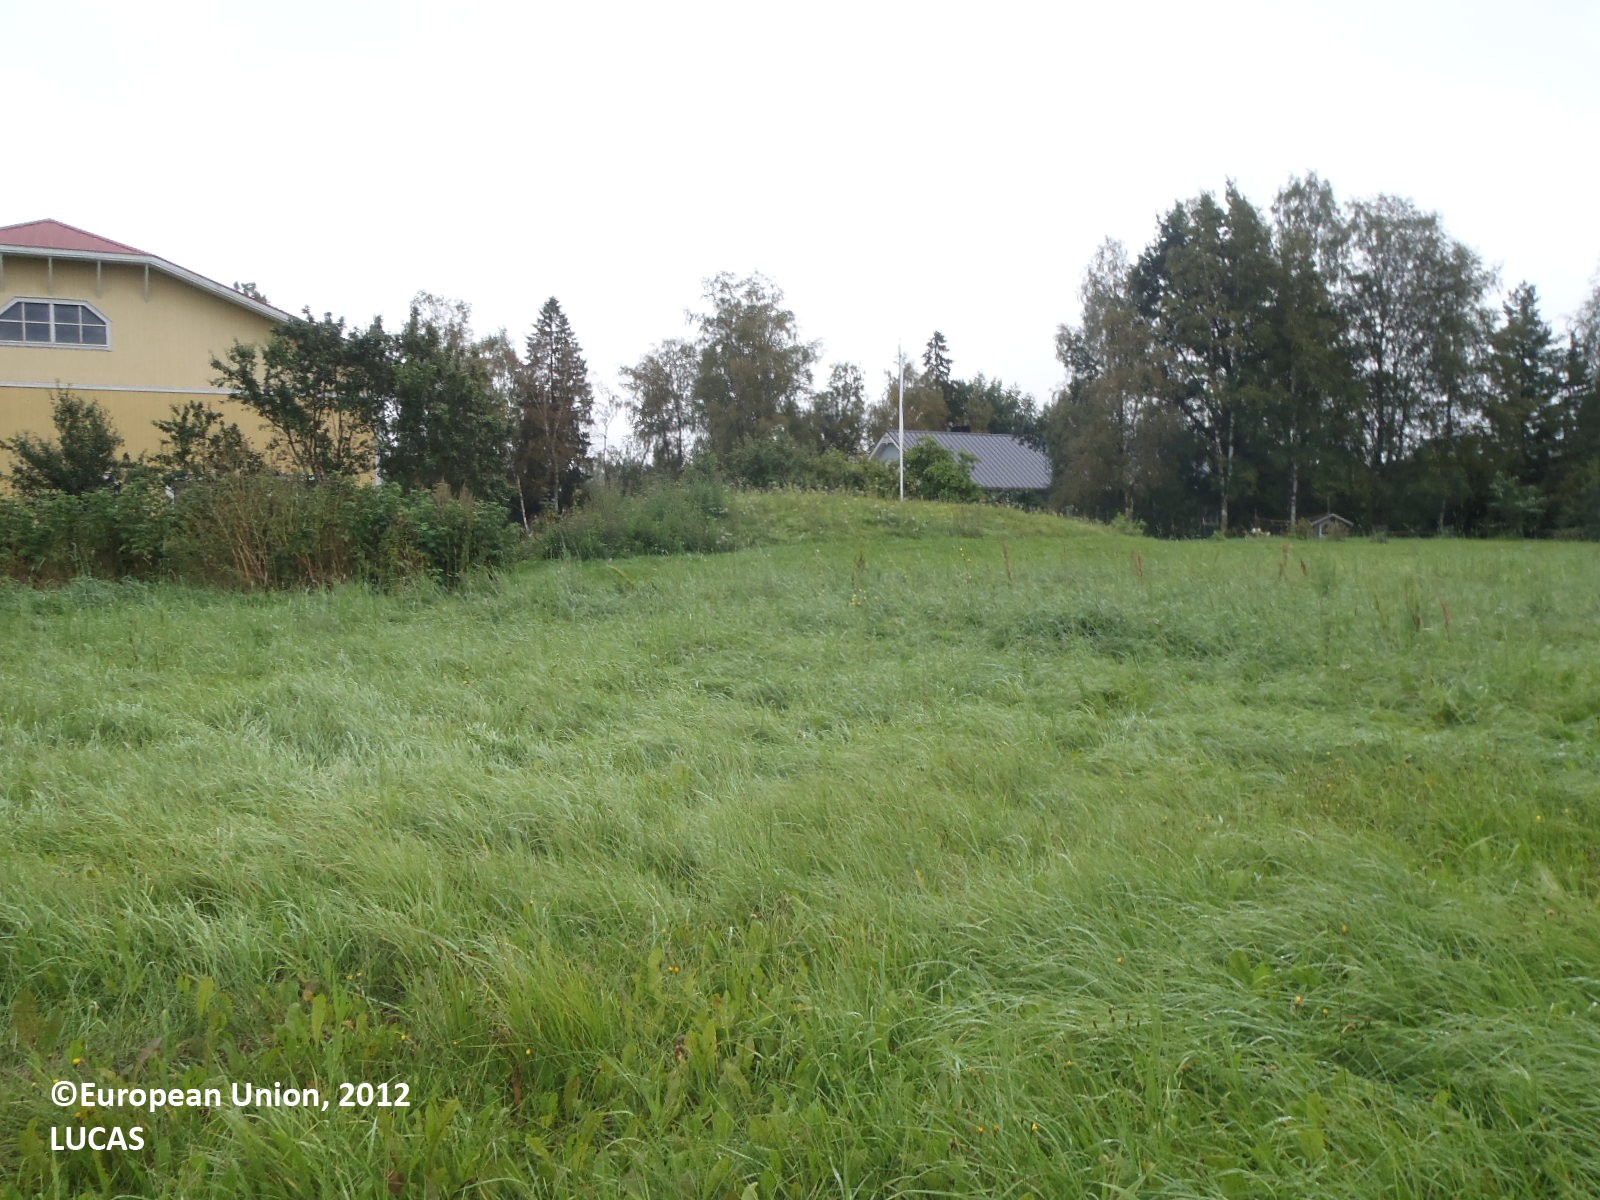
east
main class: Grassland
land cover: Grassland without tree/shrub cover
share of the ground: > 75 %
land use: Agriculture (excluding fallow land and kitchen gardens)
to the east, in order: Grassland without tree/shrub cover; Apple fruit; Artificial constructions in urban areas; Grassland without tree/shrub cover; Tracks; Broadleaved woodland; Inland running water; Broadleaved woodland; Grassland without tree/shrub cover; Pine dominated mixed woodland; Artificial constructions; Tracks; Floriculture and ornamental plants; Other fruit trees and berries; Grassland without tree/shrub cover; Fences; Grassland without tree/shrub cover
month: September
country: FI
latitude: 61.0315
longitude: 22.6741
